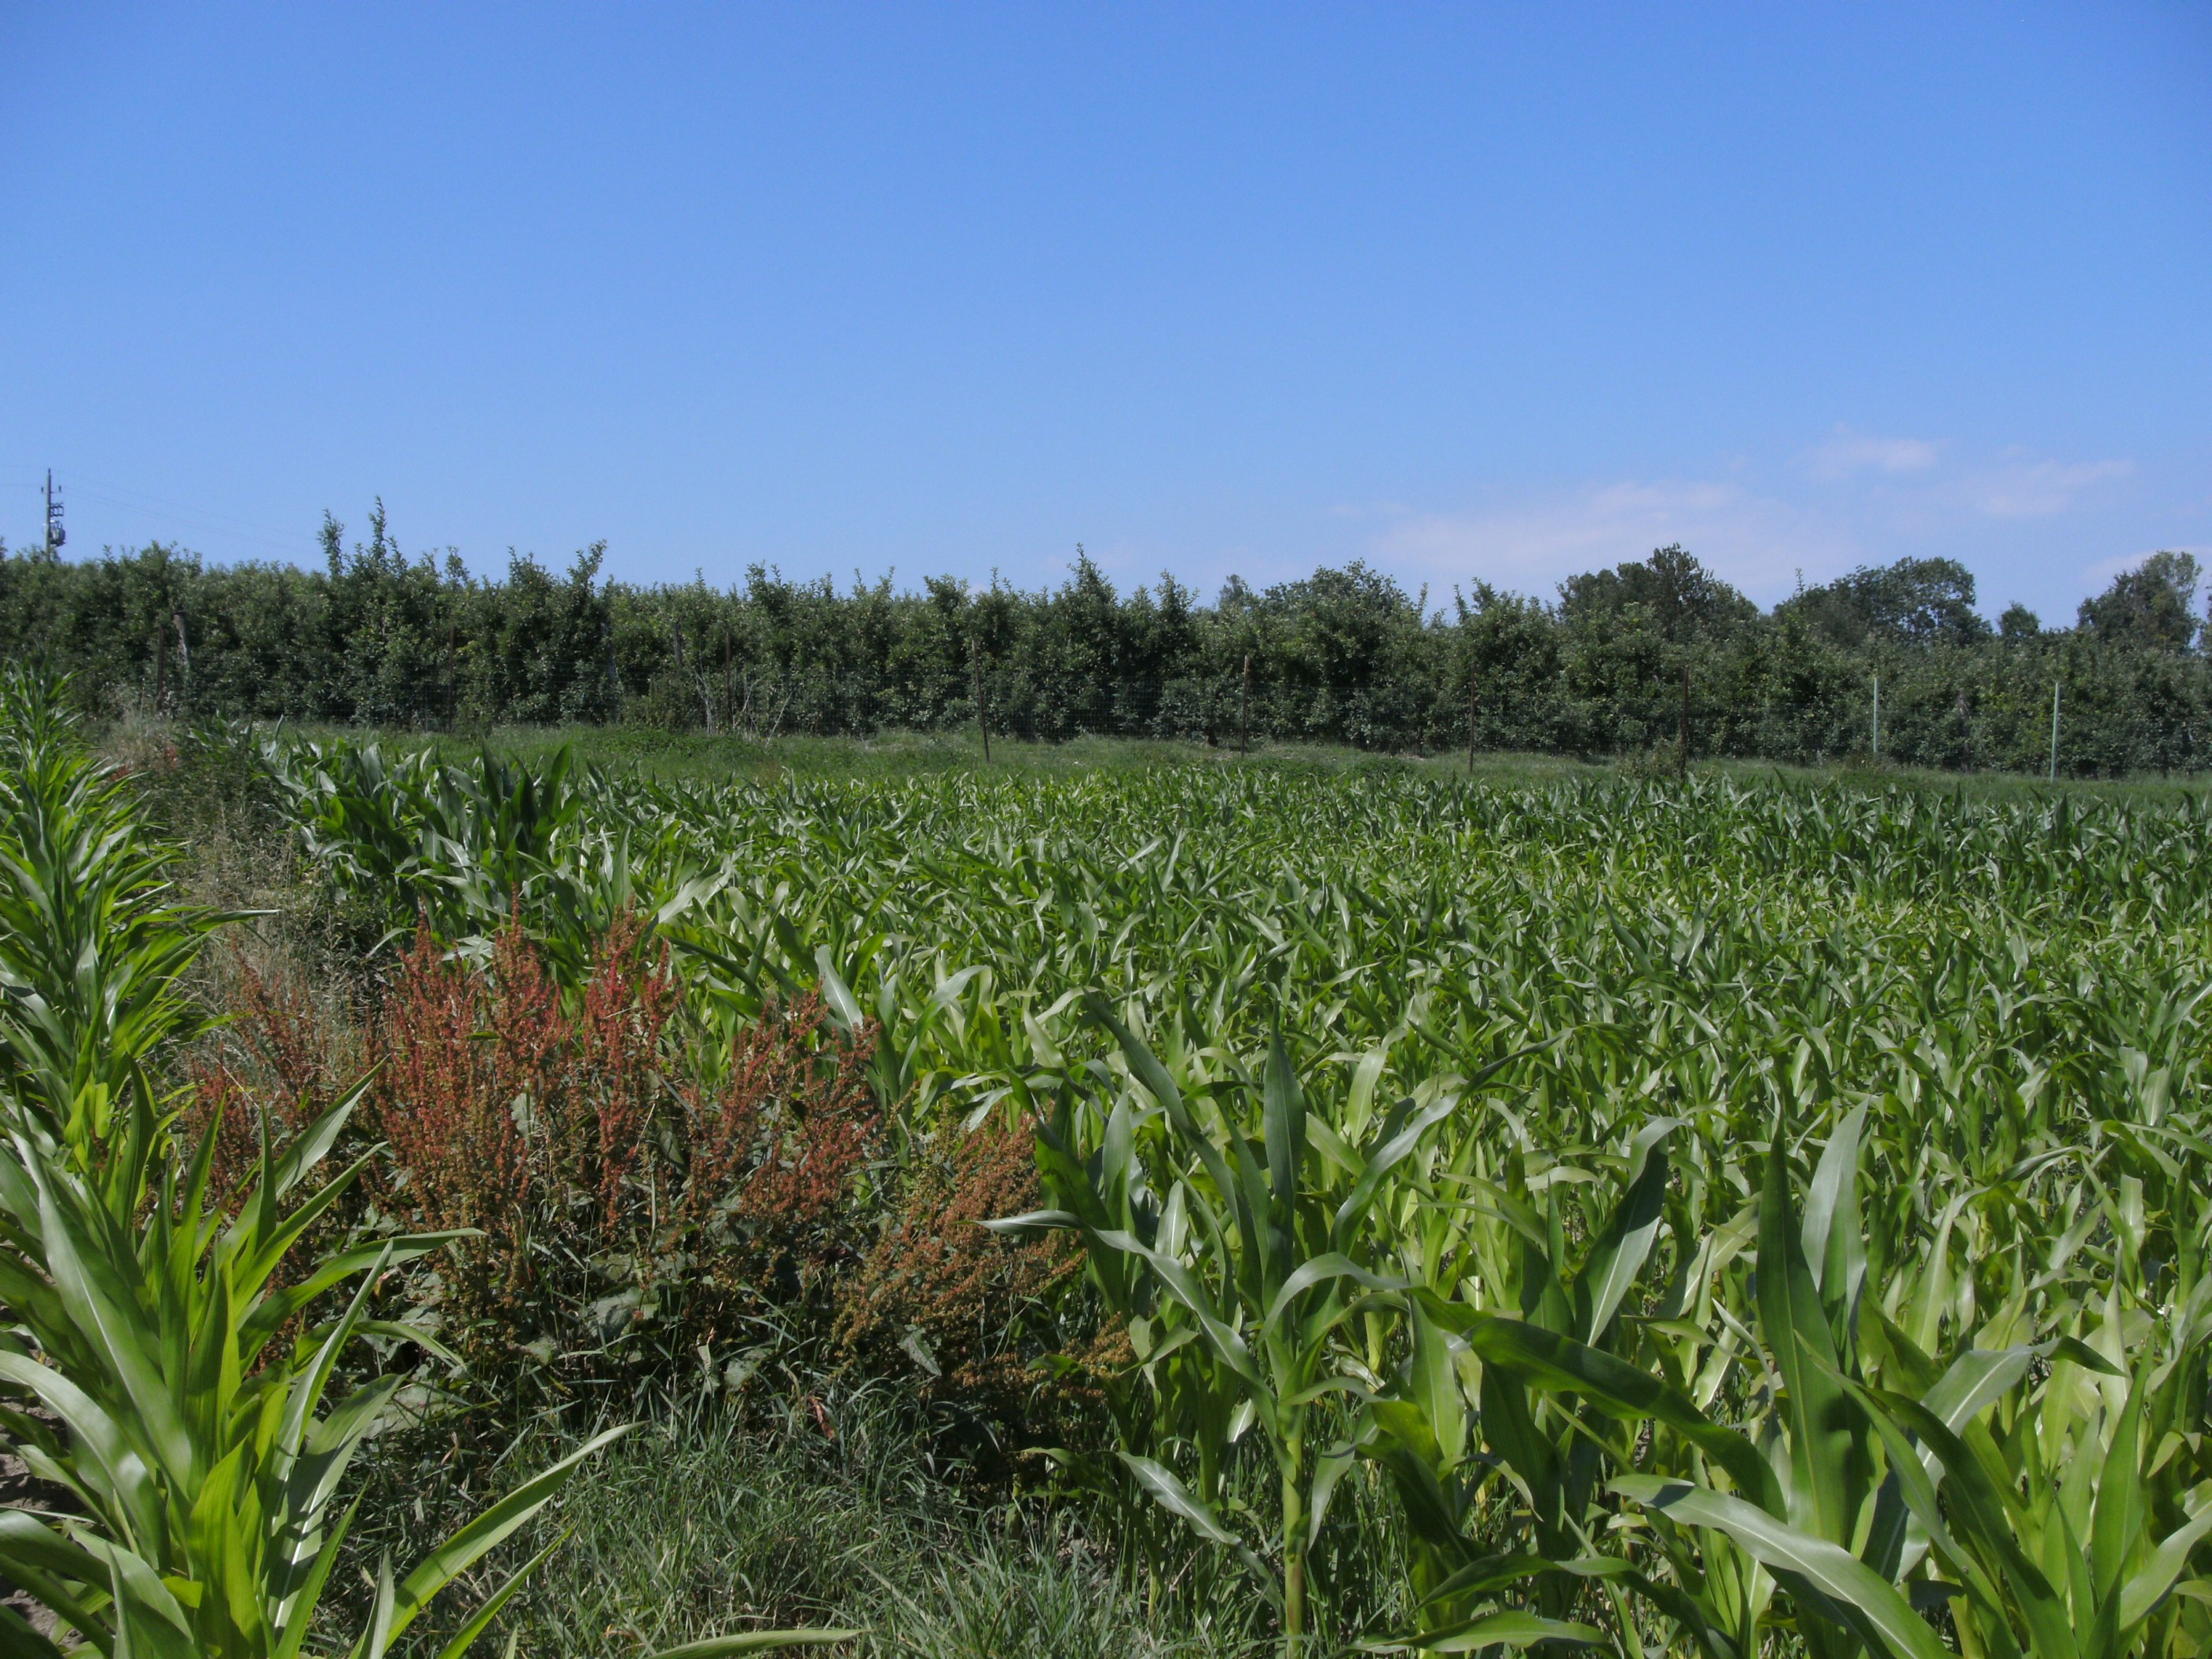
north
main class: Cropland
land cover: Maize
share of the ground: 50 - 75 %
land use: Agriculture (excluding fallow land and kitchen gardens)
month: July
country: AT
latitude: 48.2581
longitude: 14.0272
